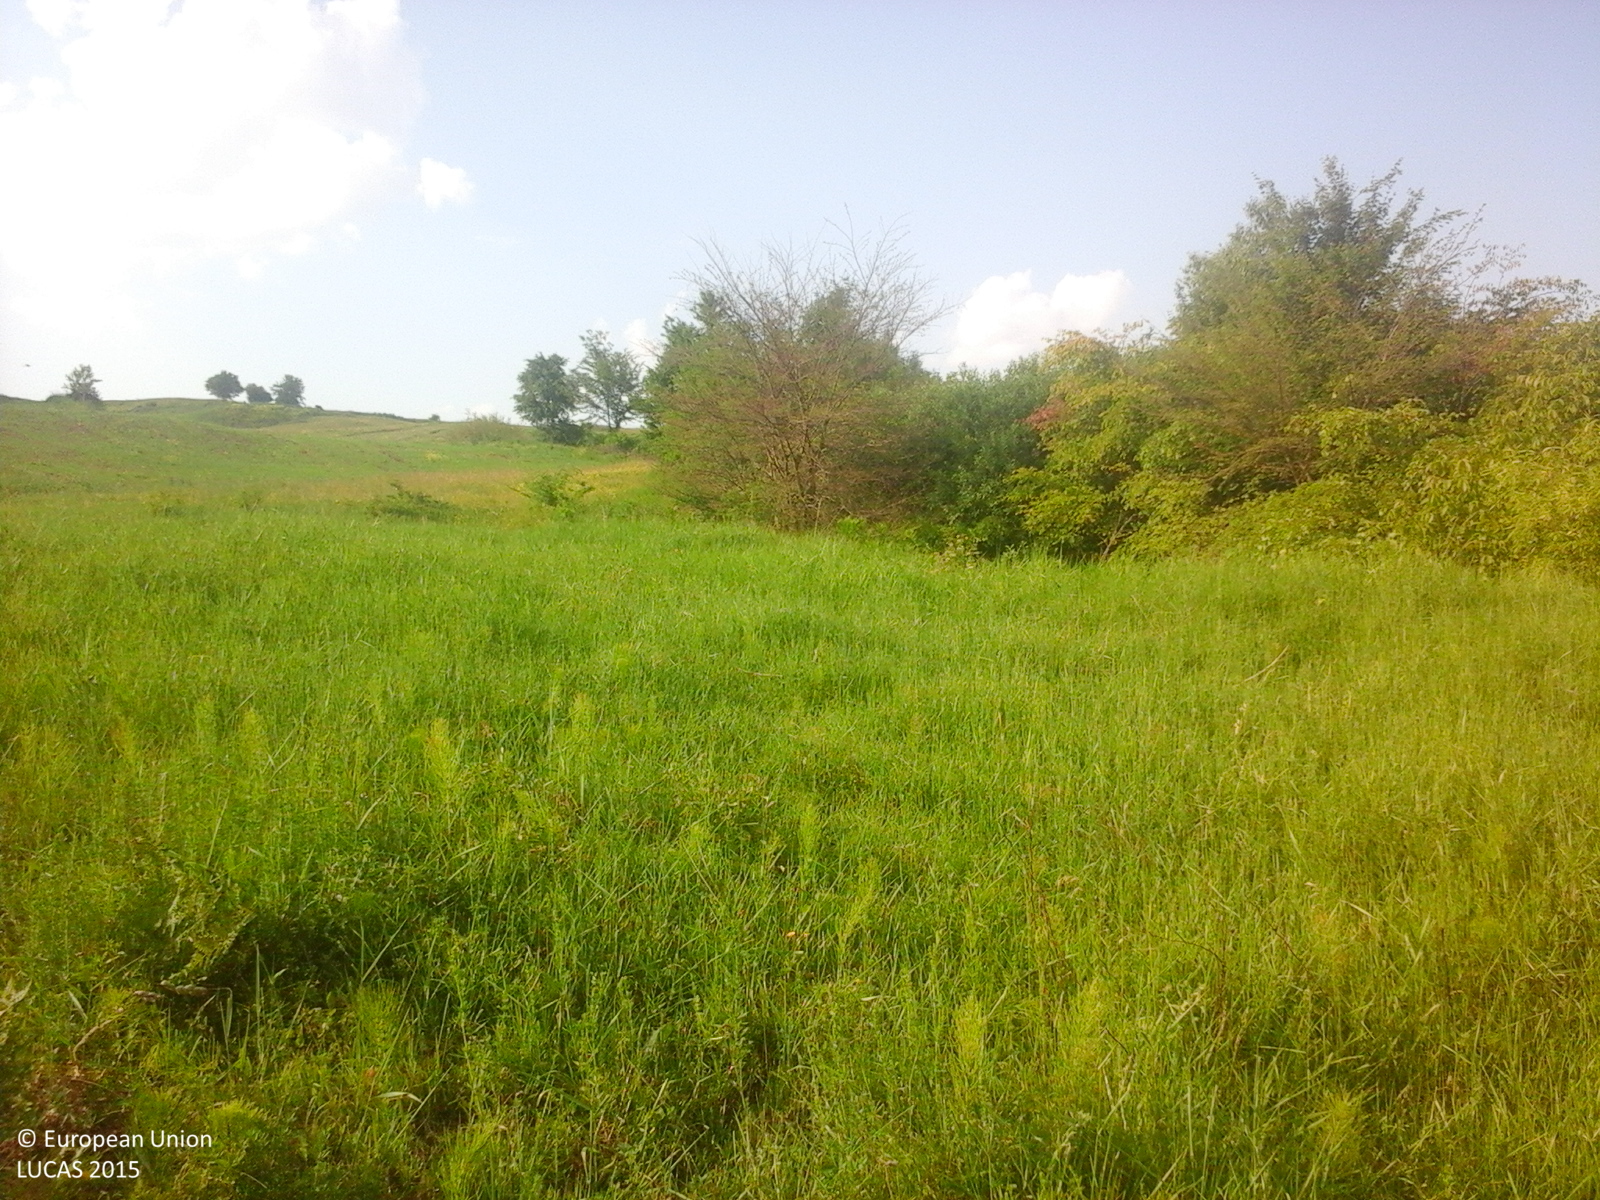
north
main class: Grassland
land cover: Grassland without tree/shrub cover
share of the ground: > 75 %
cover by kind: herbaceous plants 100 %
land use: Agriculture (excluding fallow land and kitchen gardens)
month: June
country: RO
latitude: 46.6996
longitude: 26.5771
